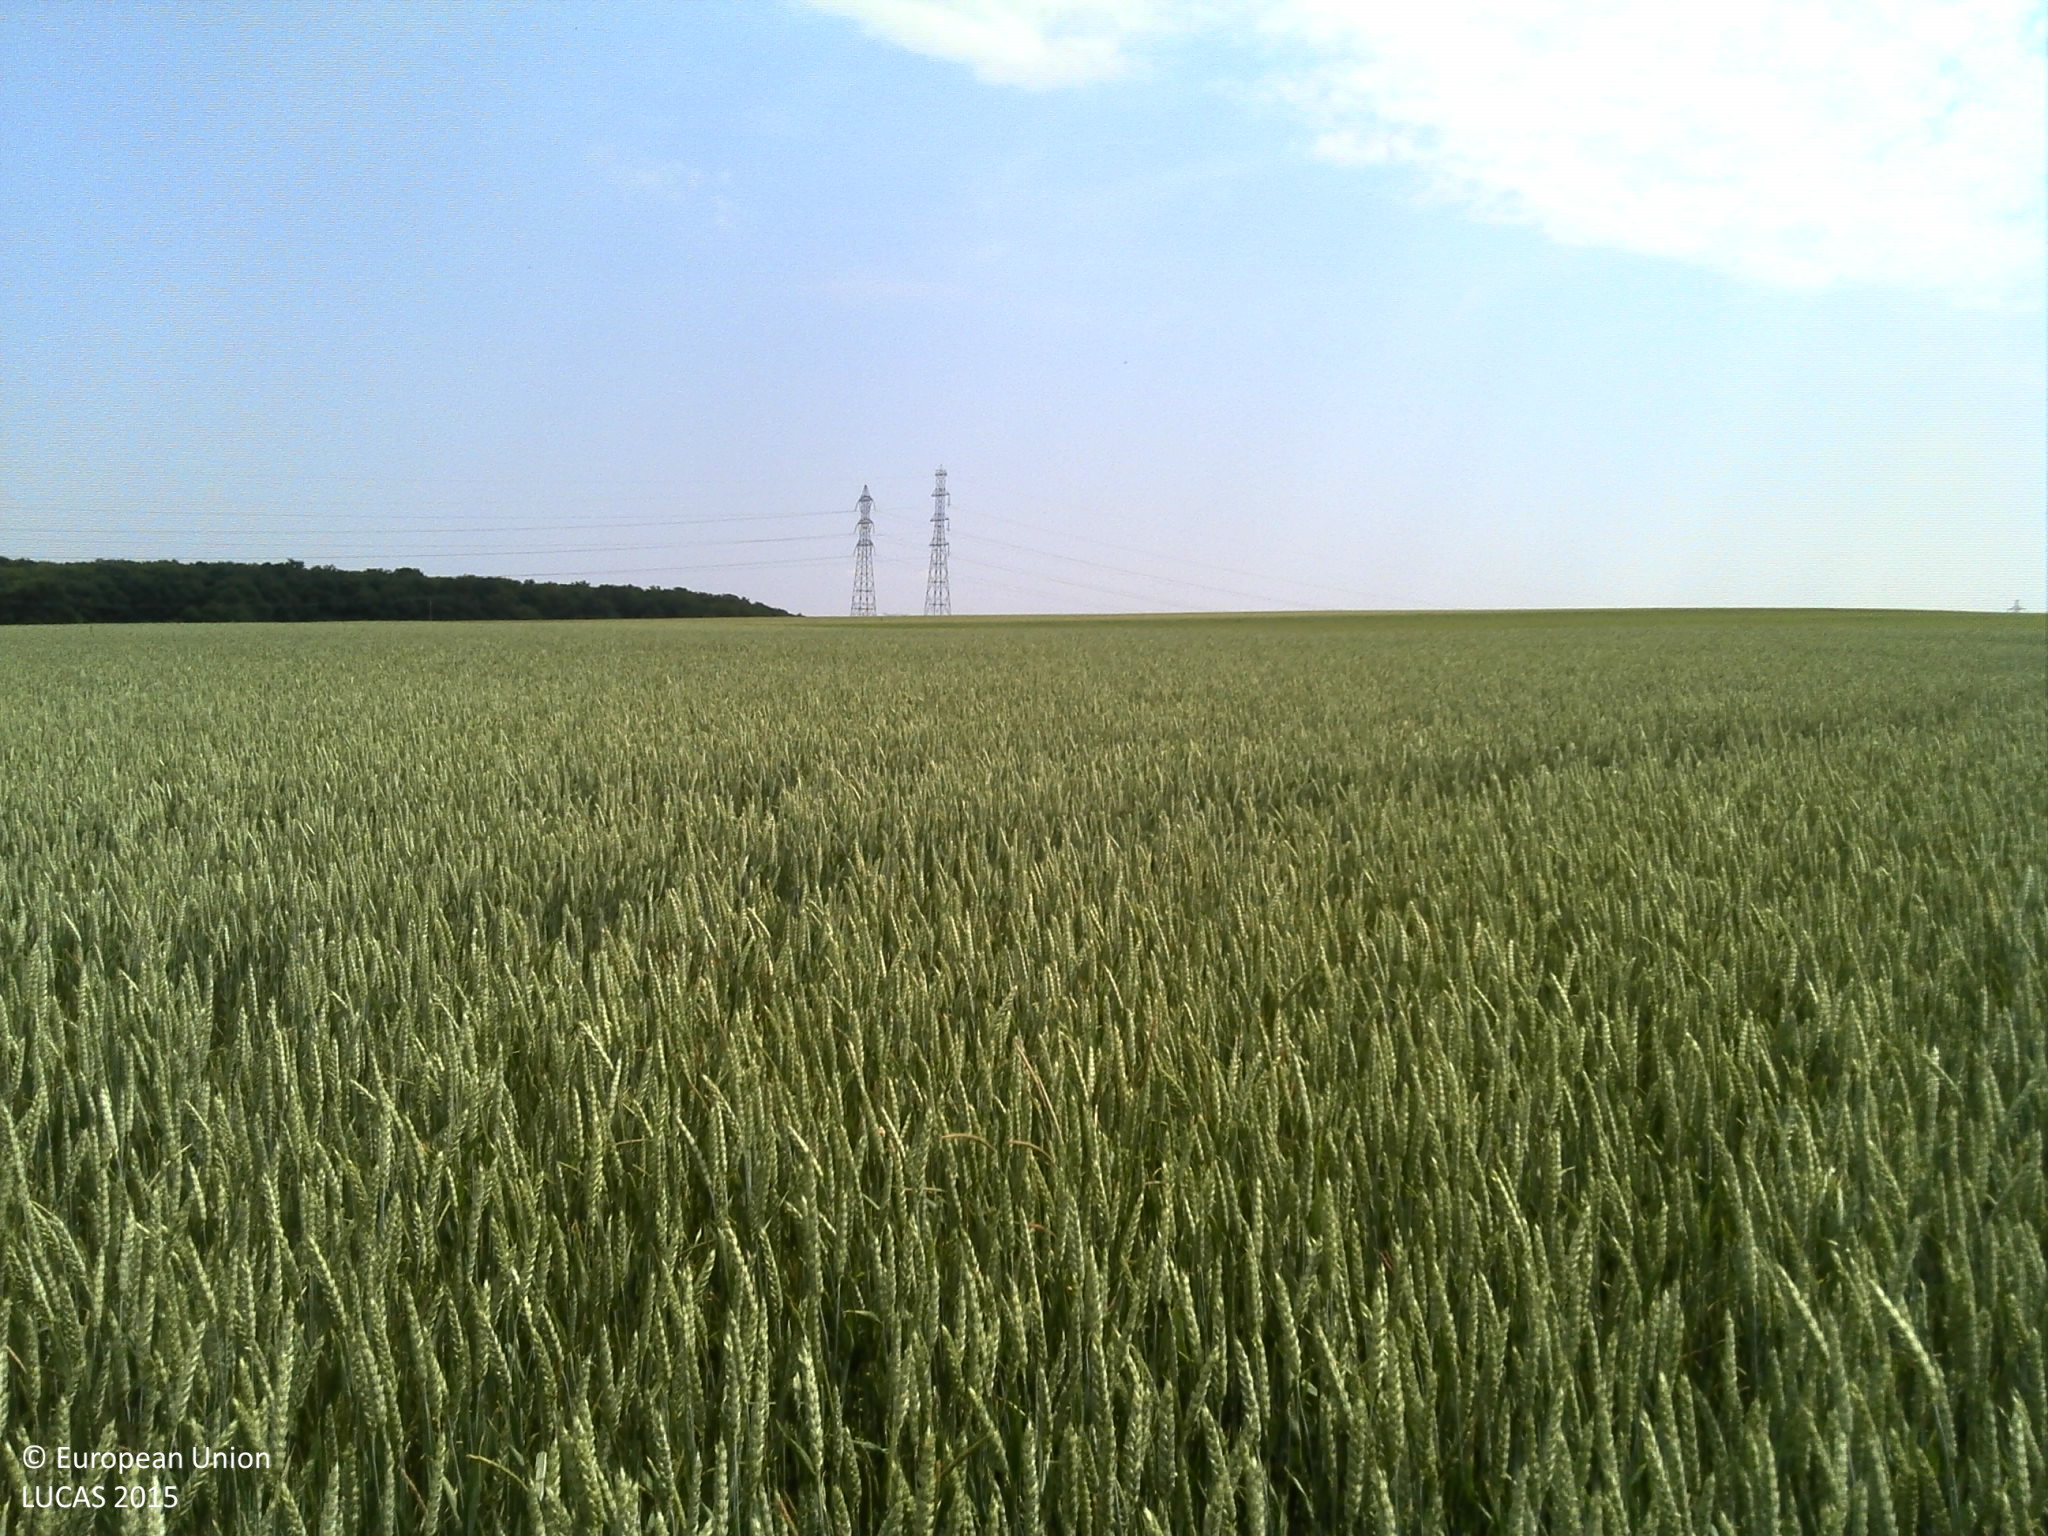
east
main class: Cropland
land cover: Common wheat
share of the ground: > 75 %
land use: Agriculture (excluding fallow land and kitchen gardens)
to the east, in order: Common wheat; Barley; Grass margins; Common wheat
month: June
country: FR
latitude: 49.2045
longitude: 6.2527
